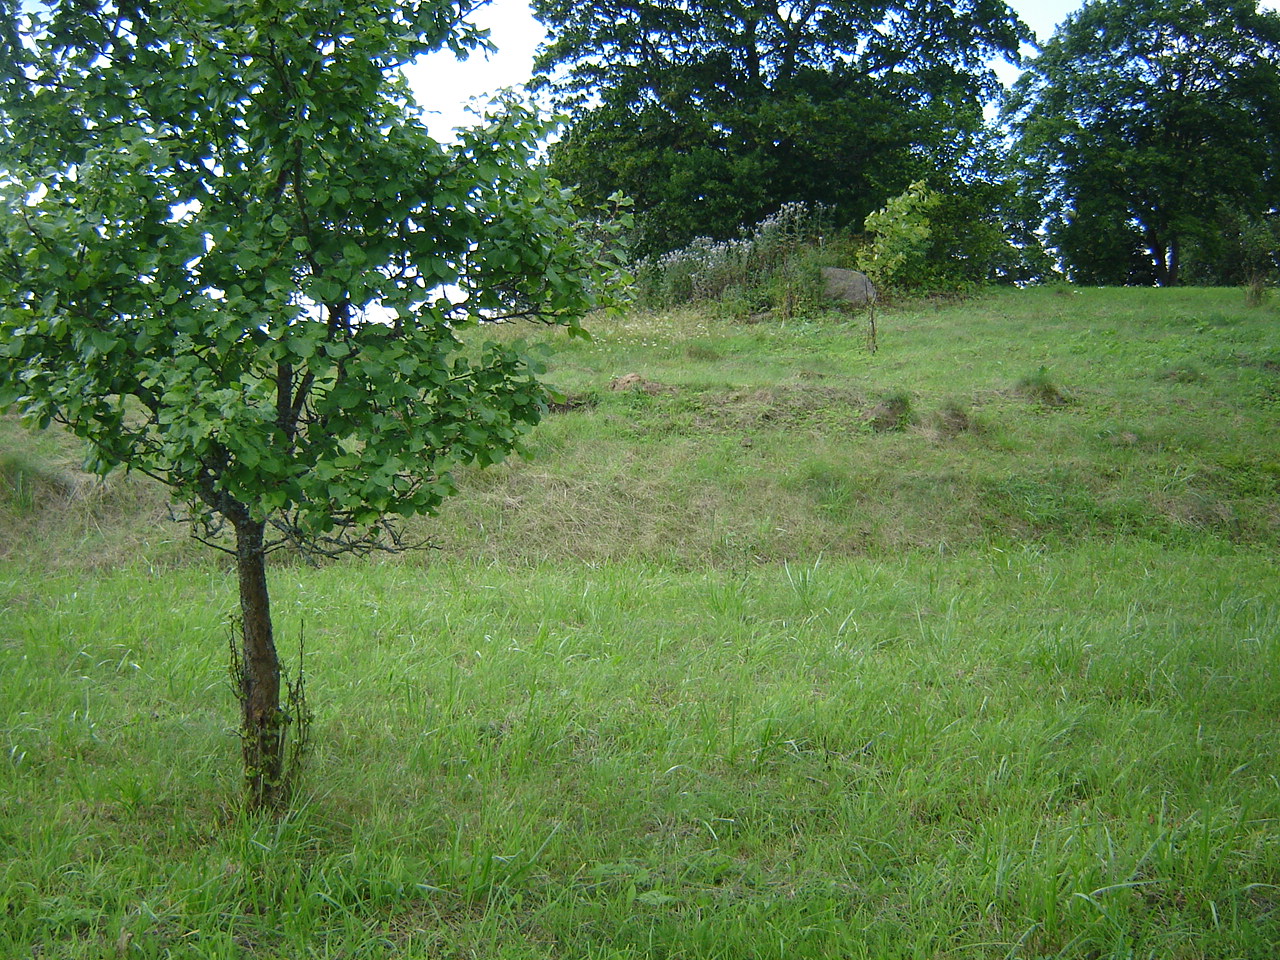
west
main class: Grassland
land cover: Grassland with sparse tree/shrub cover
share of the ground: > 75 %
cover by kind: herbaceous plants 95 %, broadleaved forest trees 5 %
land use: Agriculture (excluding fallow land and kitchen gardens)
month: July
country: LT
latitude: 55.2454
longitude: 25.1375
